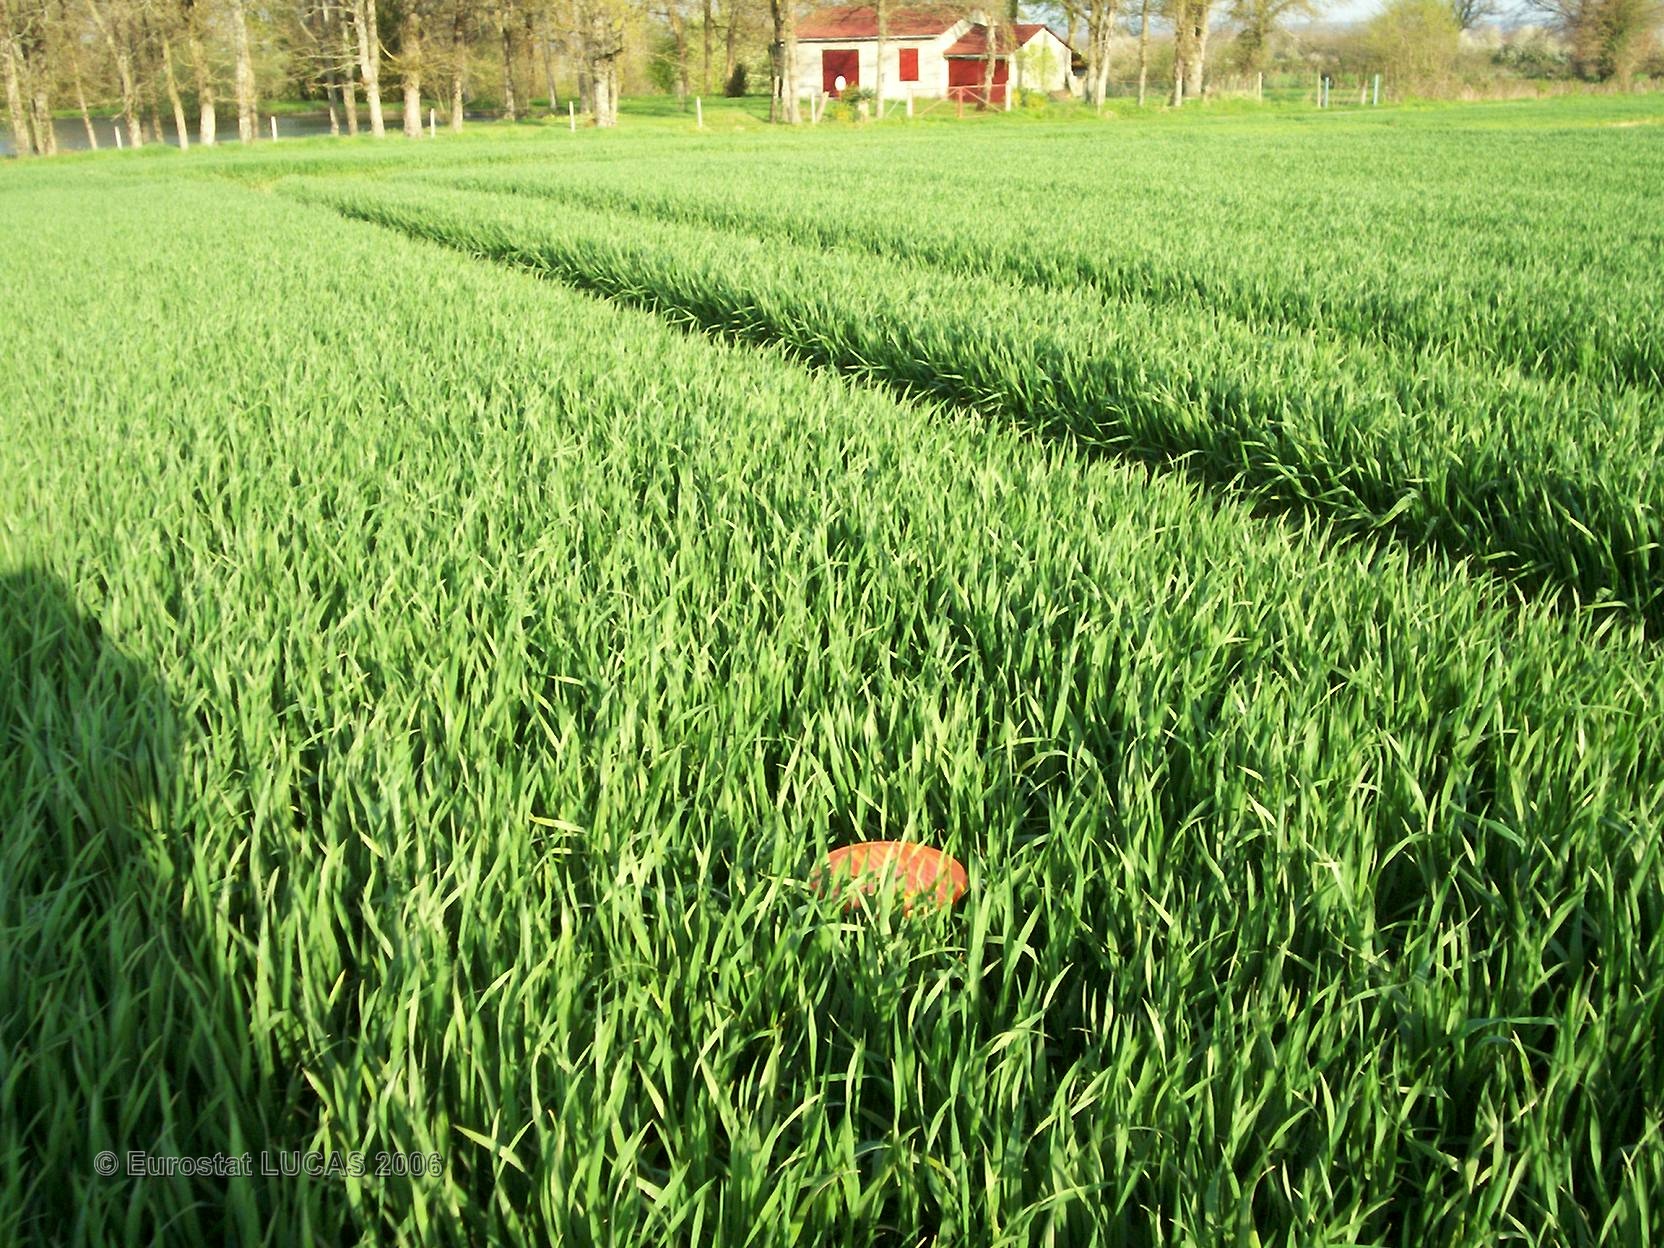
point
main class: Cropland
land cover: Common wheat
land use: Agriculture (excluding fallow land and kitchen gardens)
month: April
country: FR
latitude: 46.5815
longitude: 1.5990
